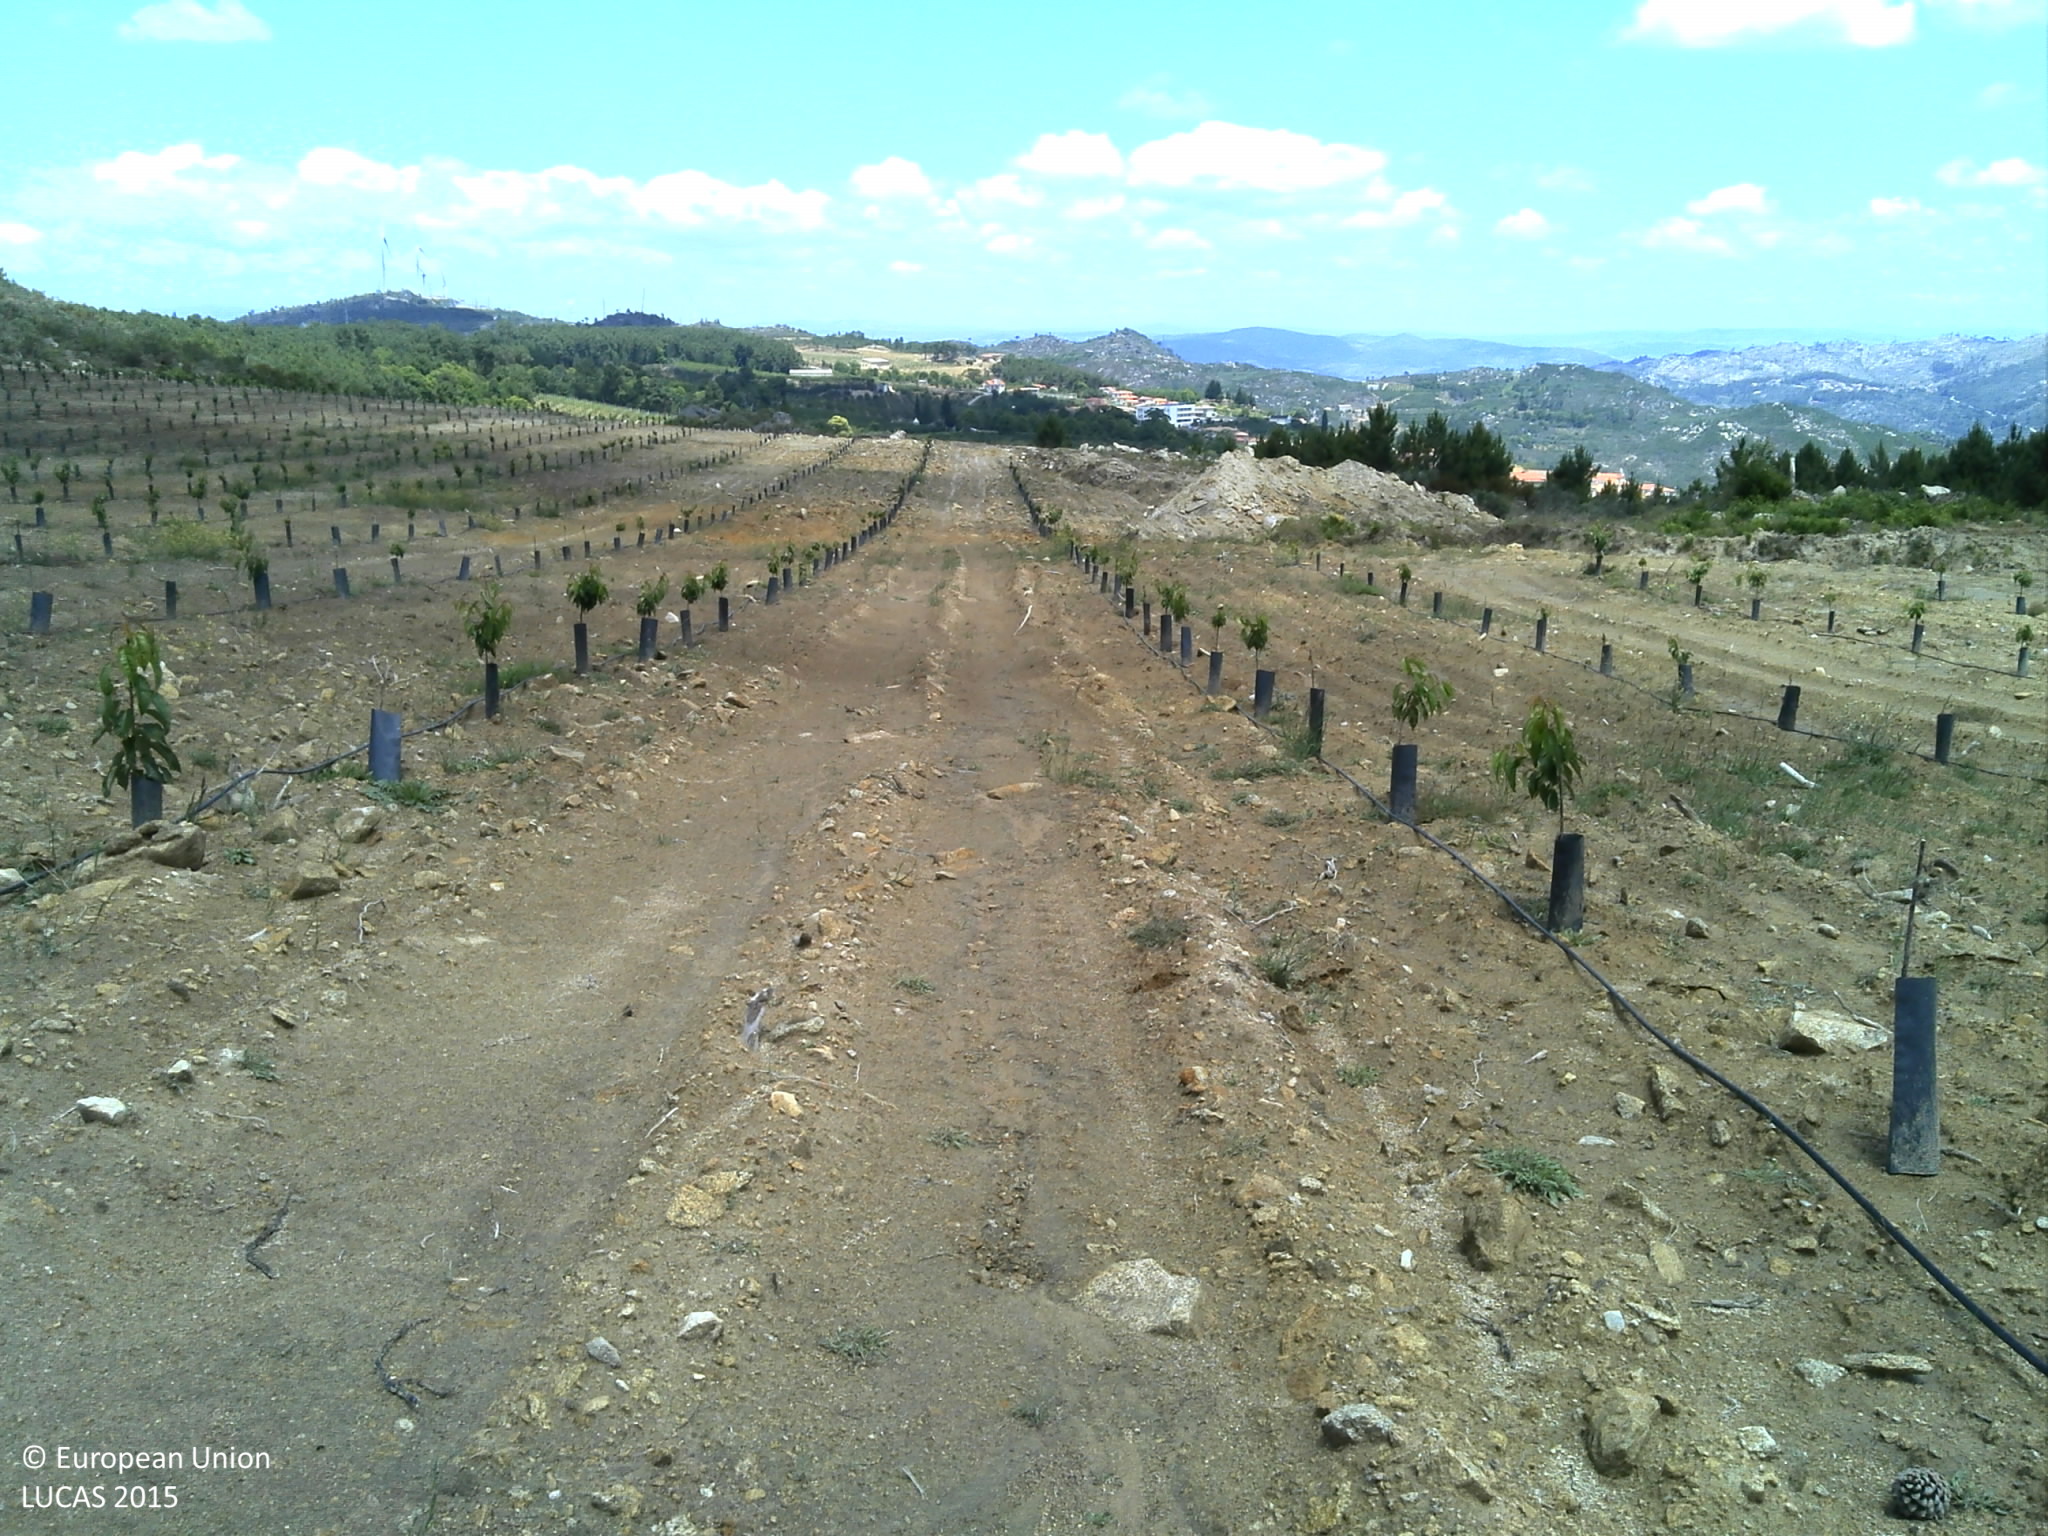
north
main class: Cropland
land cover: Cherry fruit
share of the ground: < 10 %
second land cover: Other bare soil
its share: > 75 %
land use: Agriculture (excluding fallow land and kitchen gardens)
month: June
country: PT
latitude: 41.0526
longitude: -7.6497
